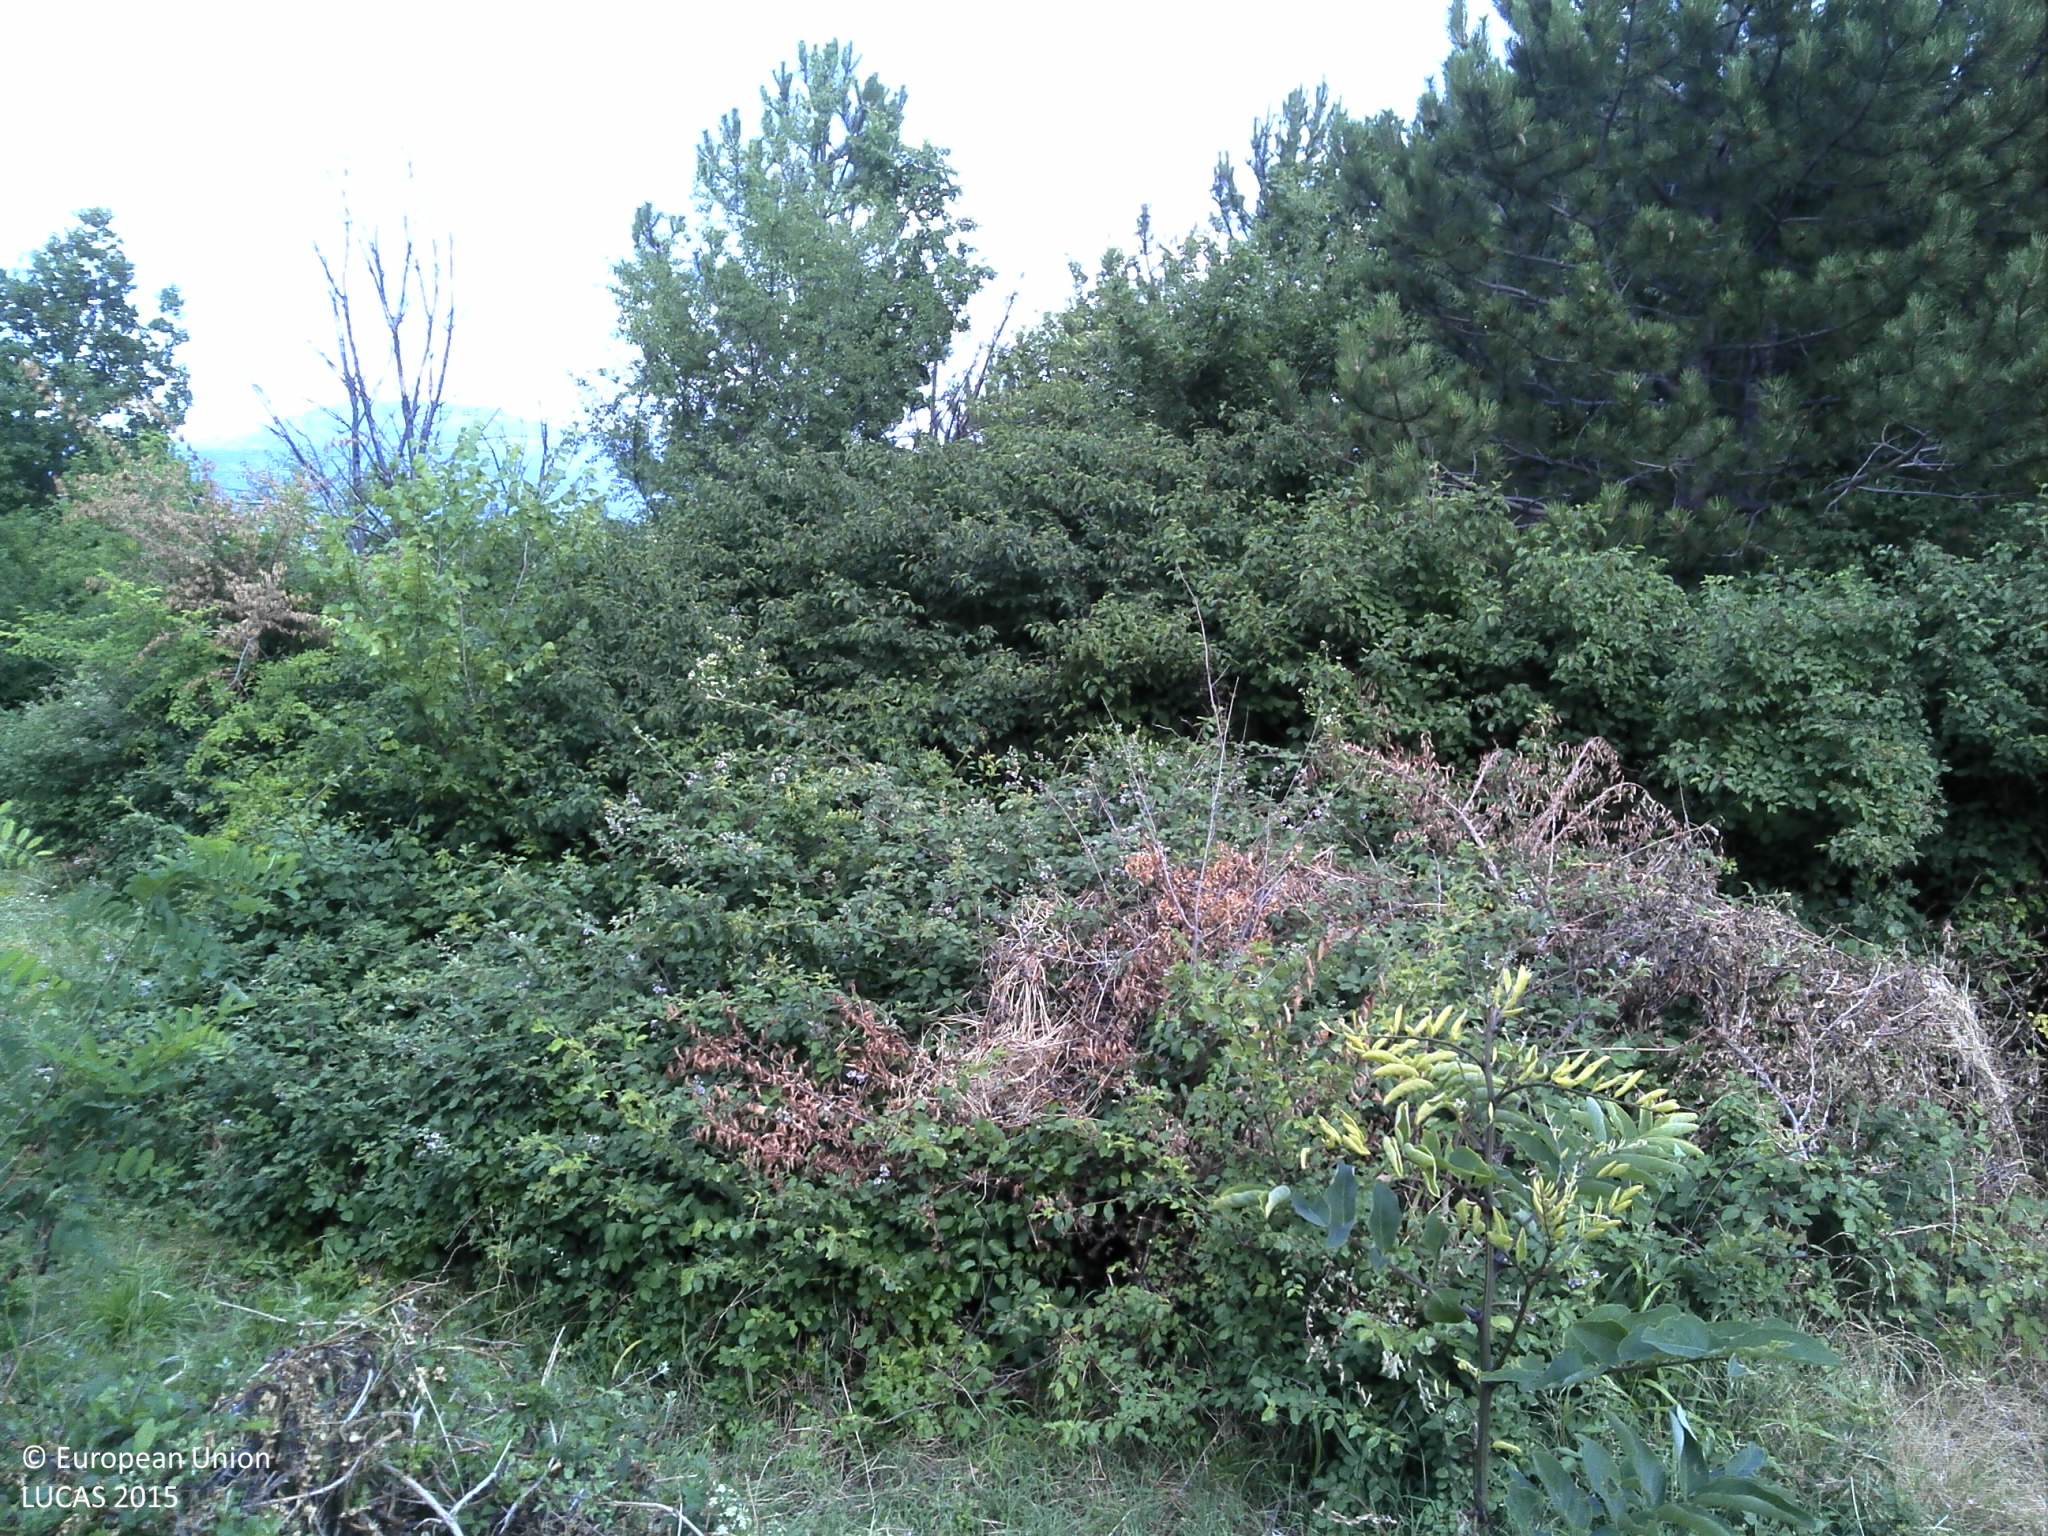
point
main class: Woodland
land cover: Broadleaved woodland
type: thermophilous deciduous forest
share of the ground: 50 - 75 %
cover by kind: broadleaved forest trees 50 %, shrubs 40 %, coniferous forest trees 10 %
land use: Semi-natural and natural areas not in use
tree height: > 5 m
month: June
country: HR
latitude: 44.0748
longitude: 16.1985
